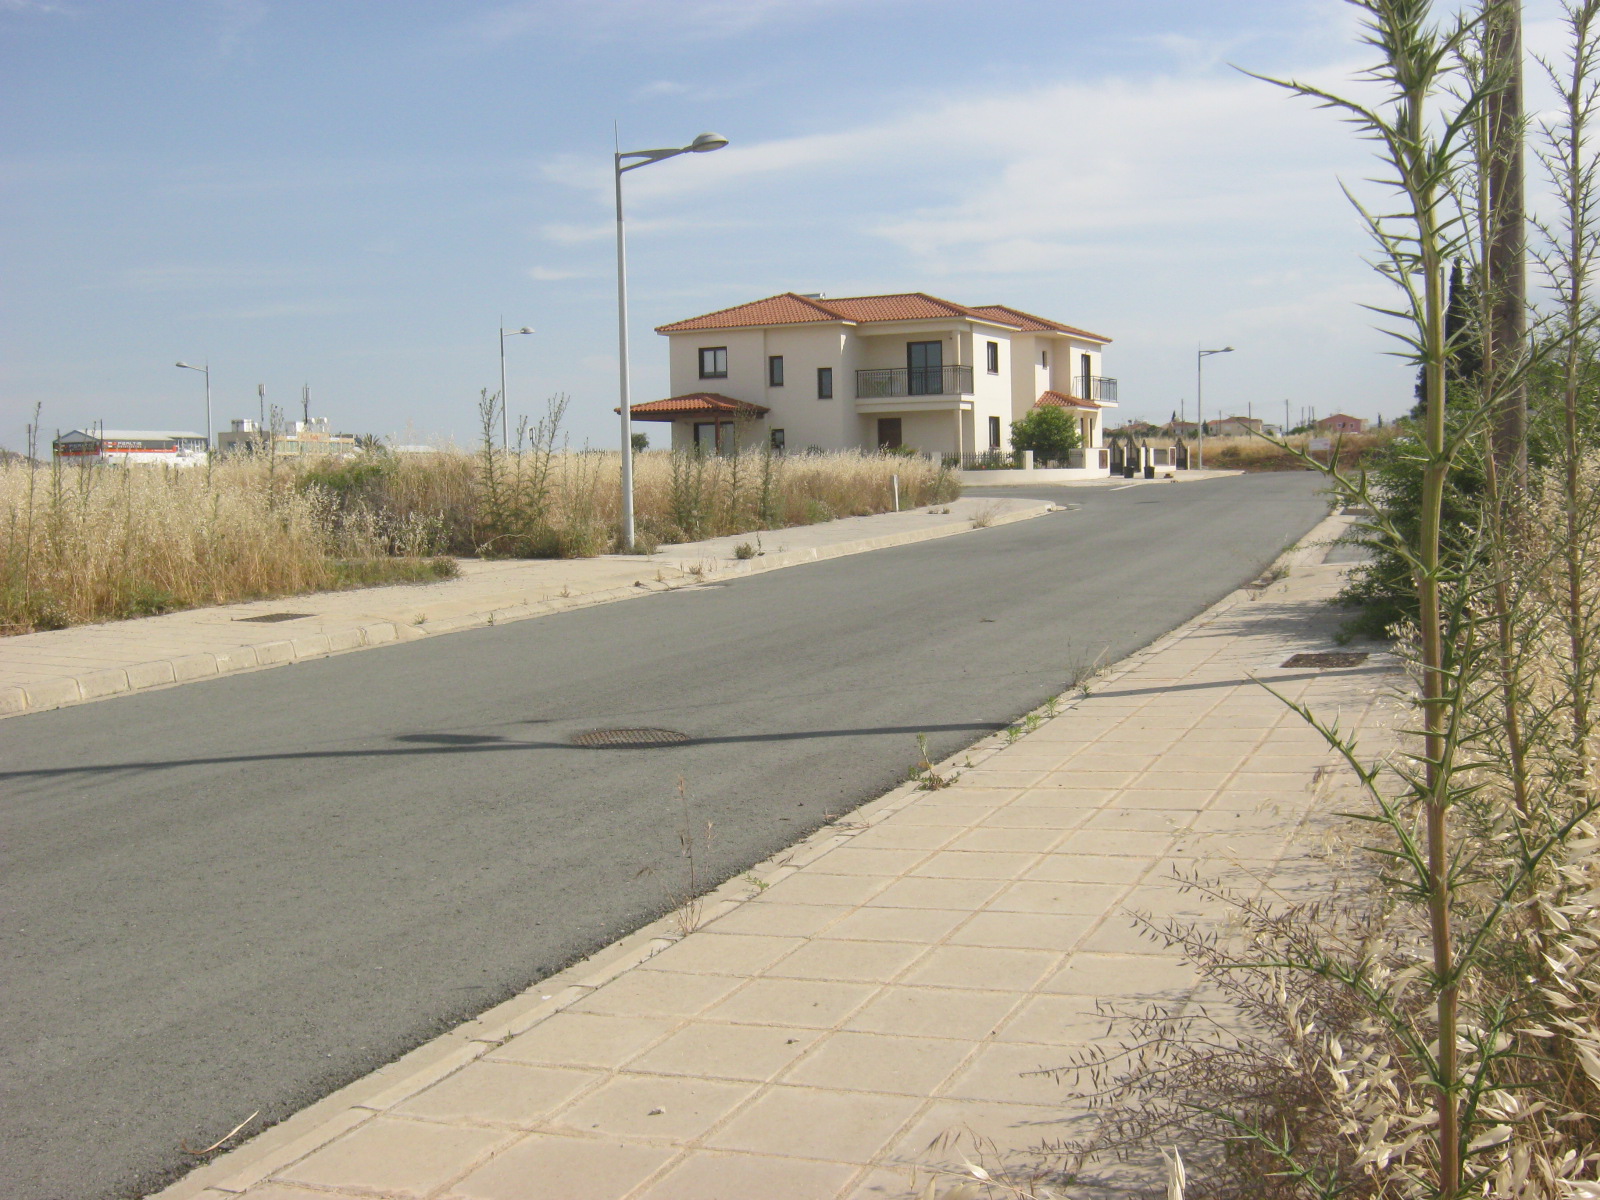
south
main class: Grassland
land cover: Spontaneously vegetated surfaces
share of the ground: > 75 %
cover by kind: herbaceous plants 100 %
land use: Agriculture (excluding fallow land and kitchen gardens)
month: May
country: CY
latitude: 35.1037
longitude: 33.3274
